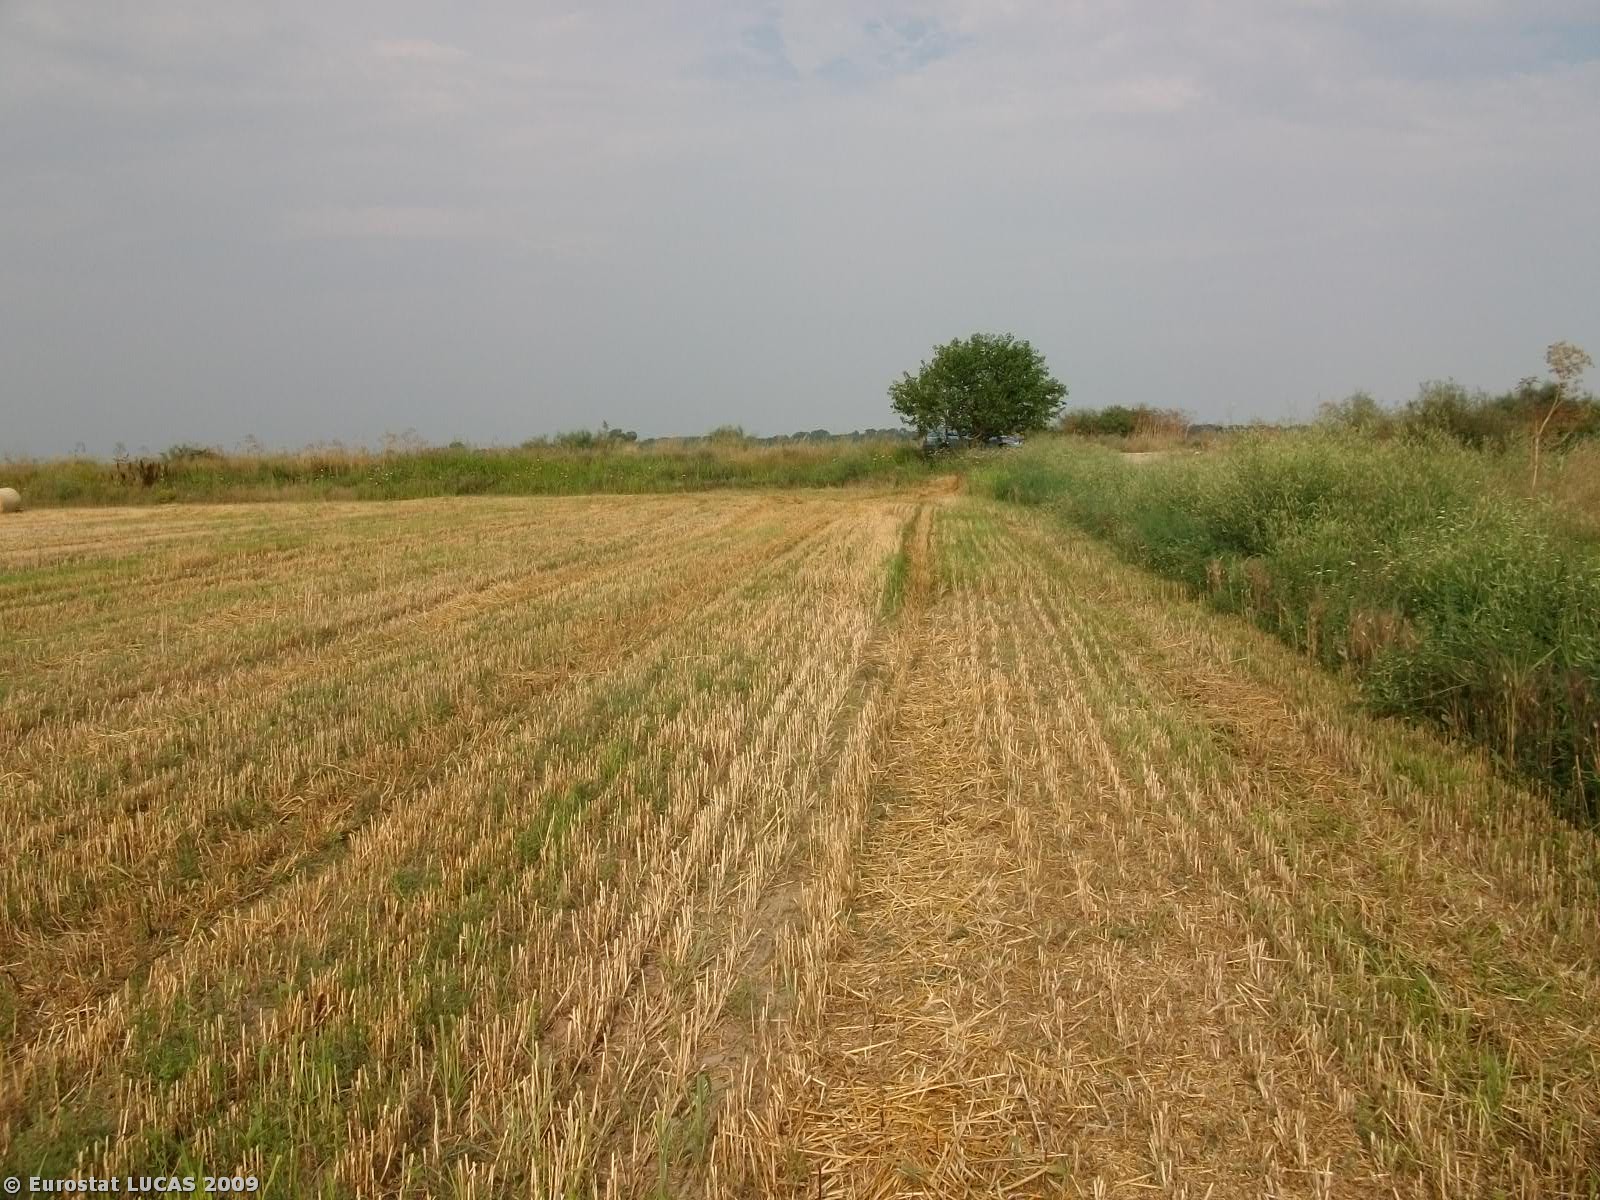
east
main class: Cropland
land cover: Durum wheat
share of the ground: < 10 %
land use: Agriculture (excluding fallow land and kitchen gardens)
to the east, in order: Durum wheat; Grass margins; Ditches and canals; Grass margins; Single bushes/trees; Paved roads, cycling and walking lanes; Grass margins; Inland running water; Grass margins; Paved roads, cycling and walking lanes; Grass margins; Paved roads, cycling and walking lanes; Grass margins; Ditches and canals; Grass margins; Durum wheat
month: July
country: GR
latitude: 40.8639
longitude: 26.1860
